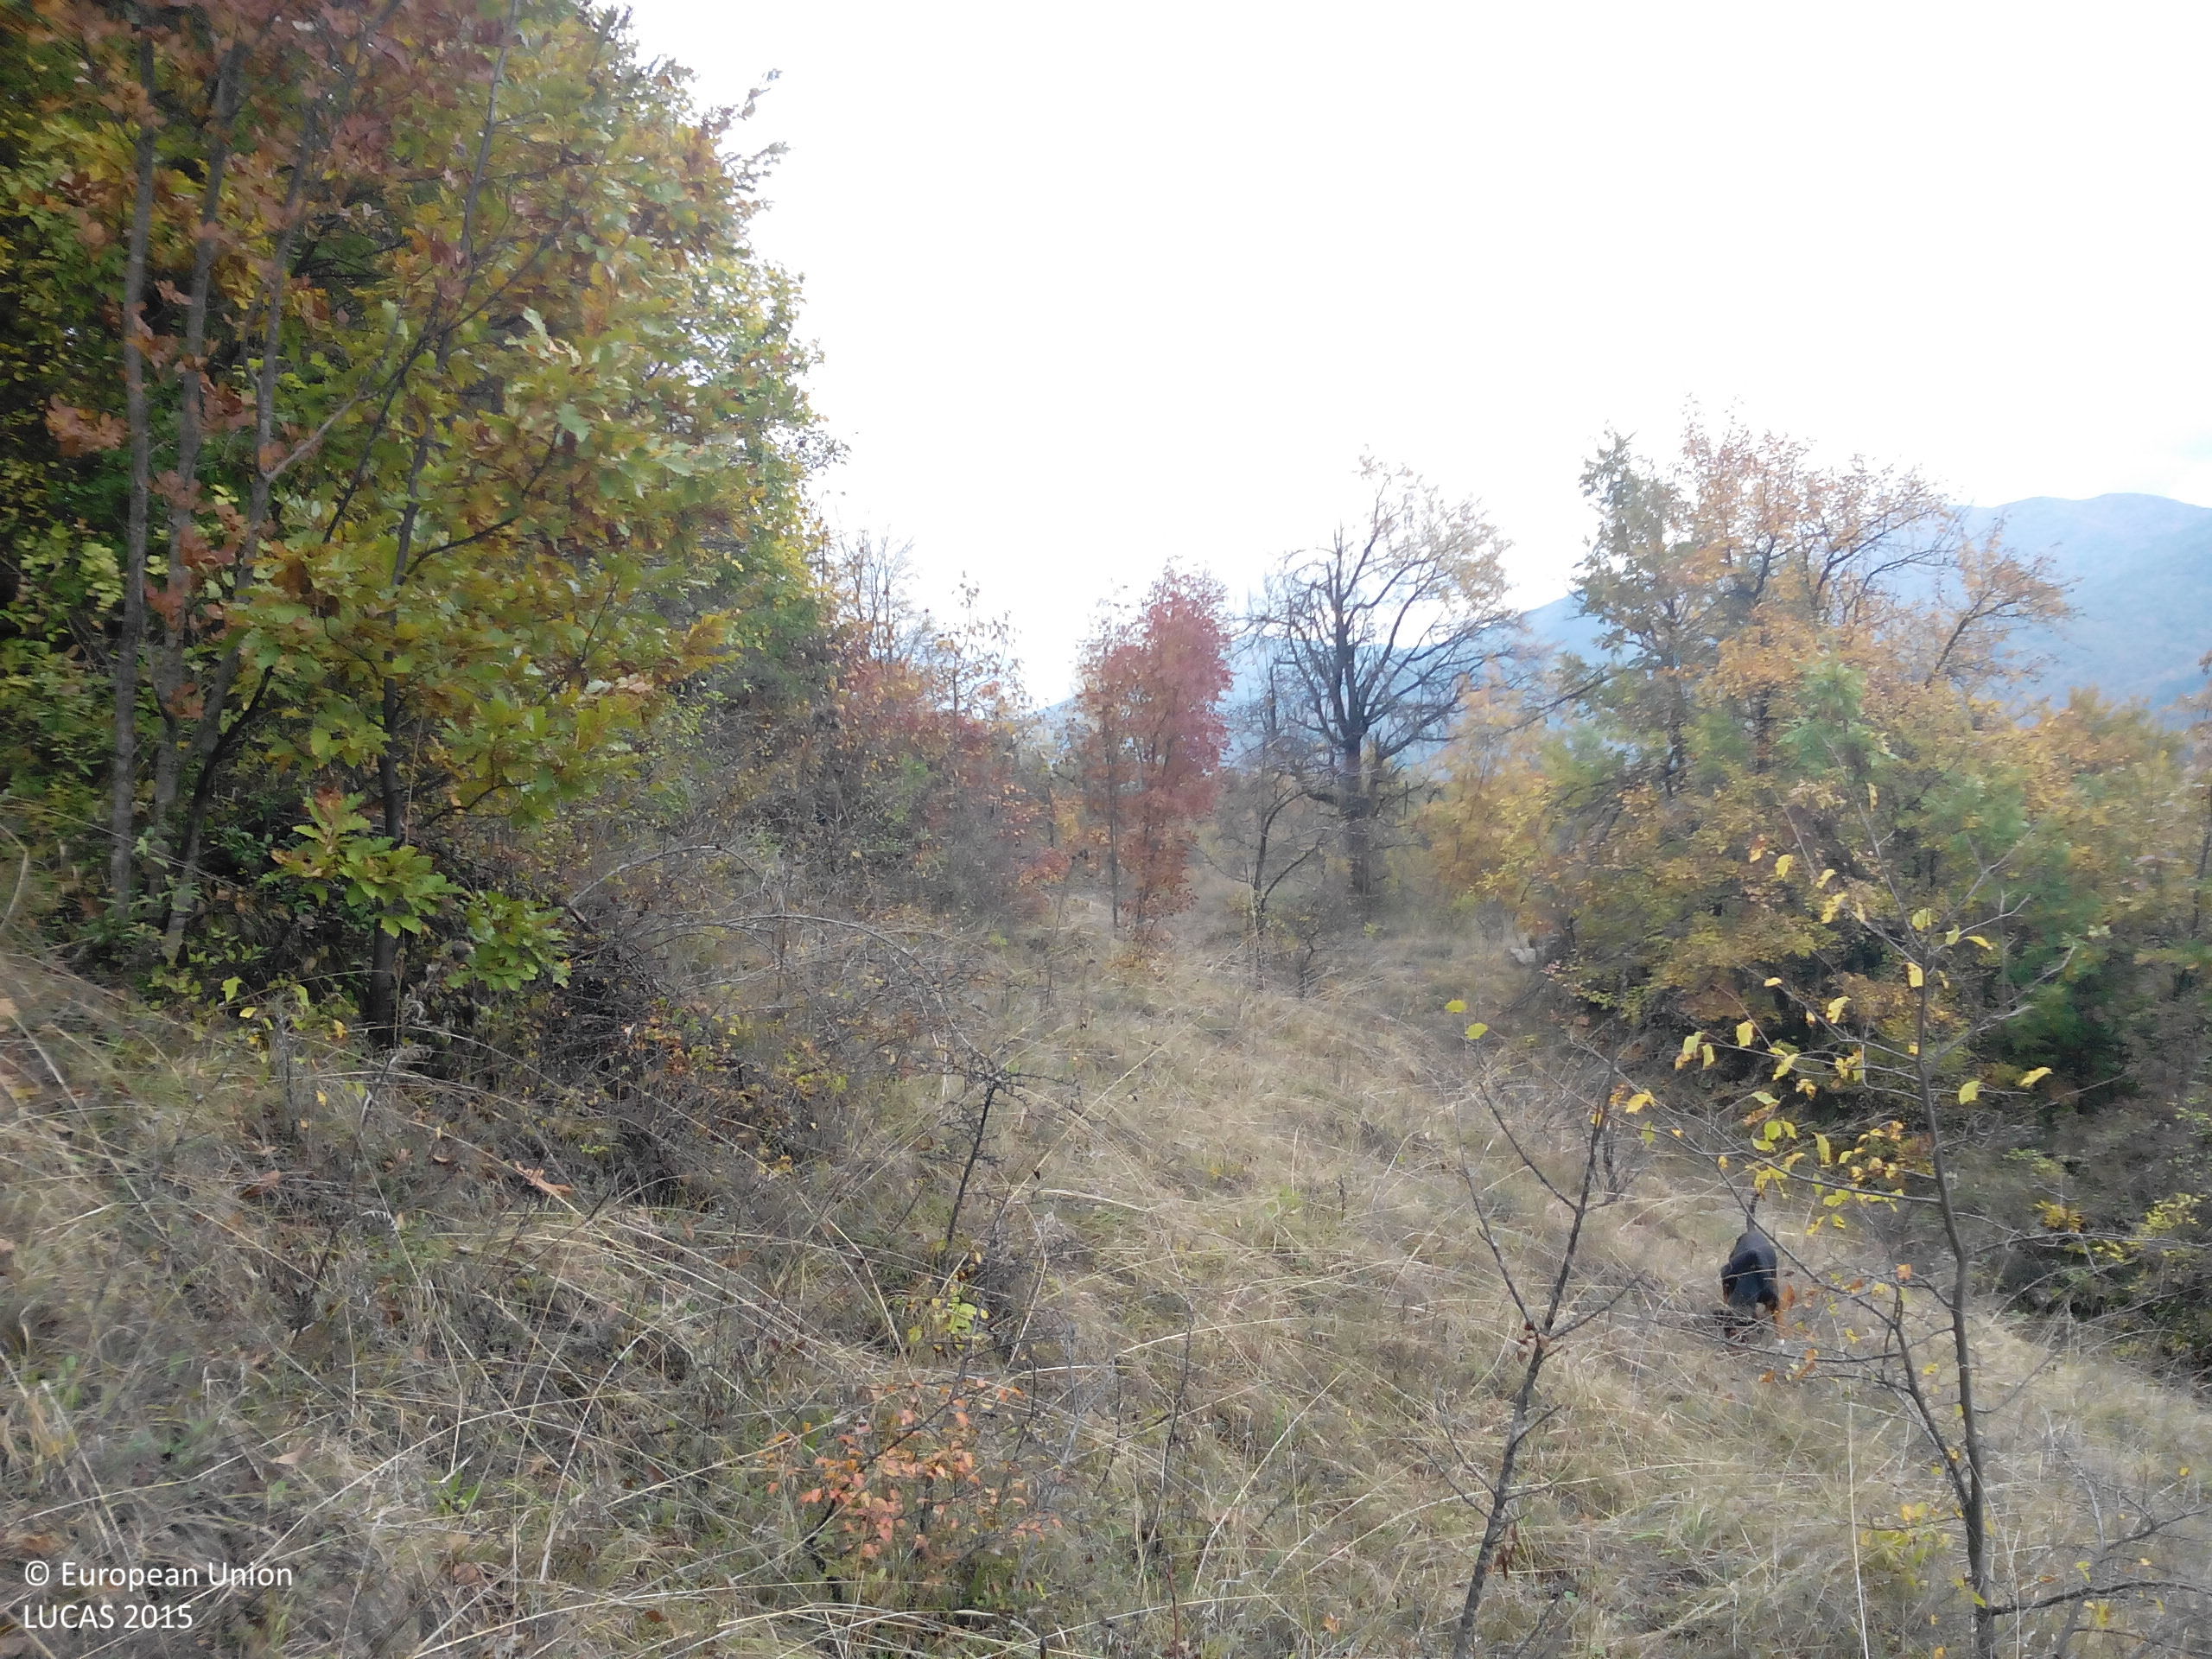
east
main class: Woodland
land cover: Broadleaved woodland
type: mesophytic deciduous forest
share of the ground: > 75 %
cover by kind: broadleaved forest trees 90 %, shrubs 5 %, herbaceous plants 5 %
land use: Semi-natural and natural areas not in use
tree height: > 5 m
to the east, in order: Broadleaved woodland; Spontaneously vegetated surfaces; Groves; Dry stone walls; Groves; Shrubland with sparse tree cover; Broadleaved woodland
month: October
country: BG
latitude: 42.9935
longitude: 23.8688
